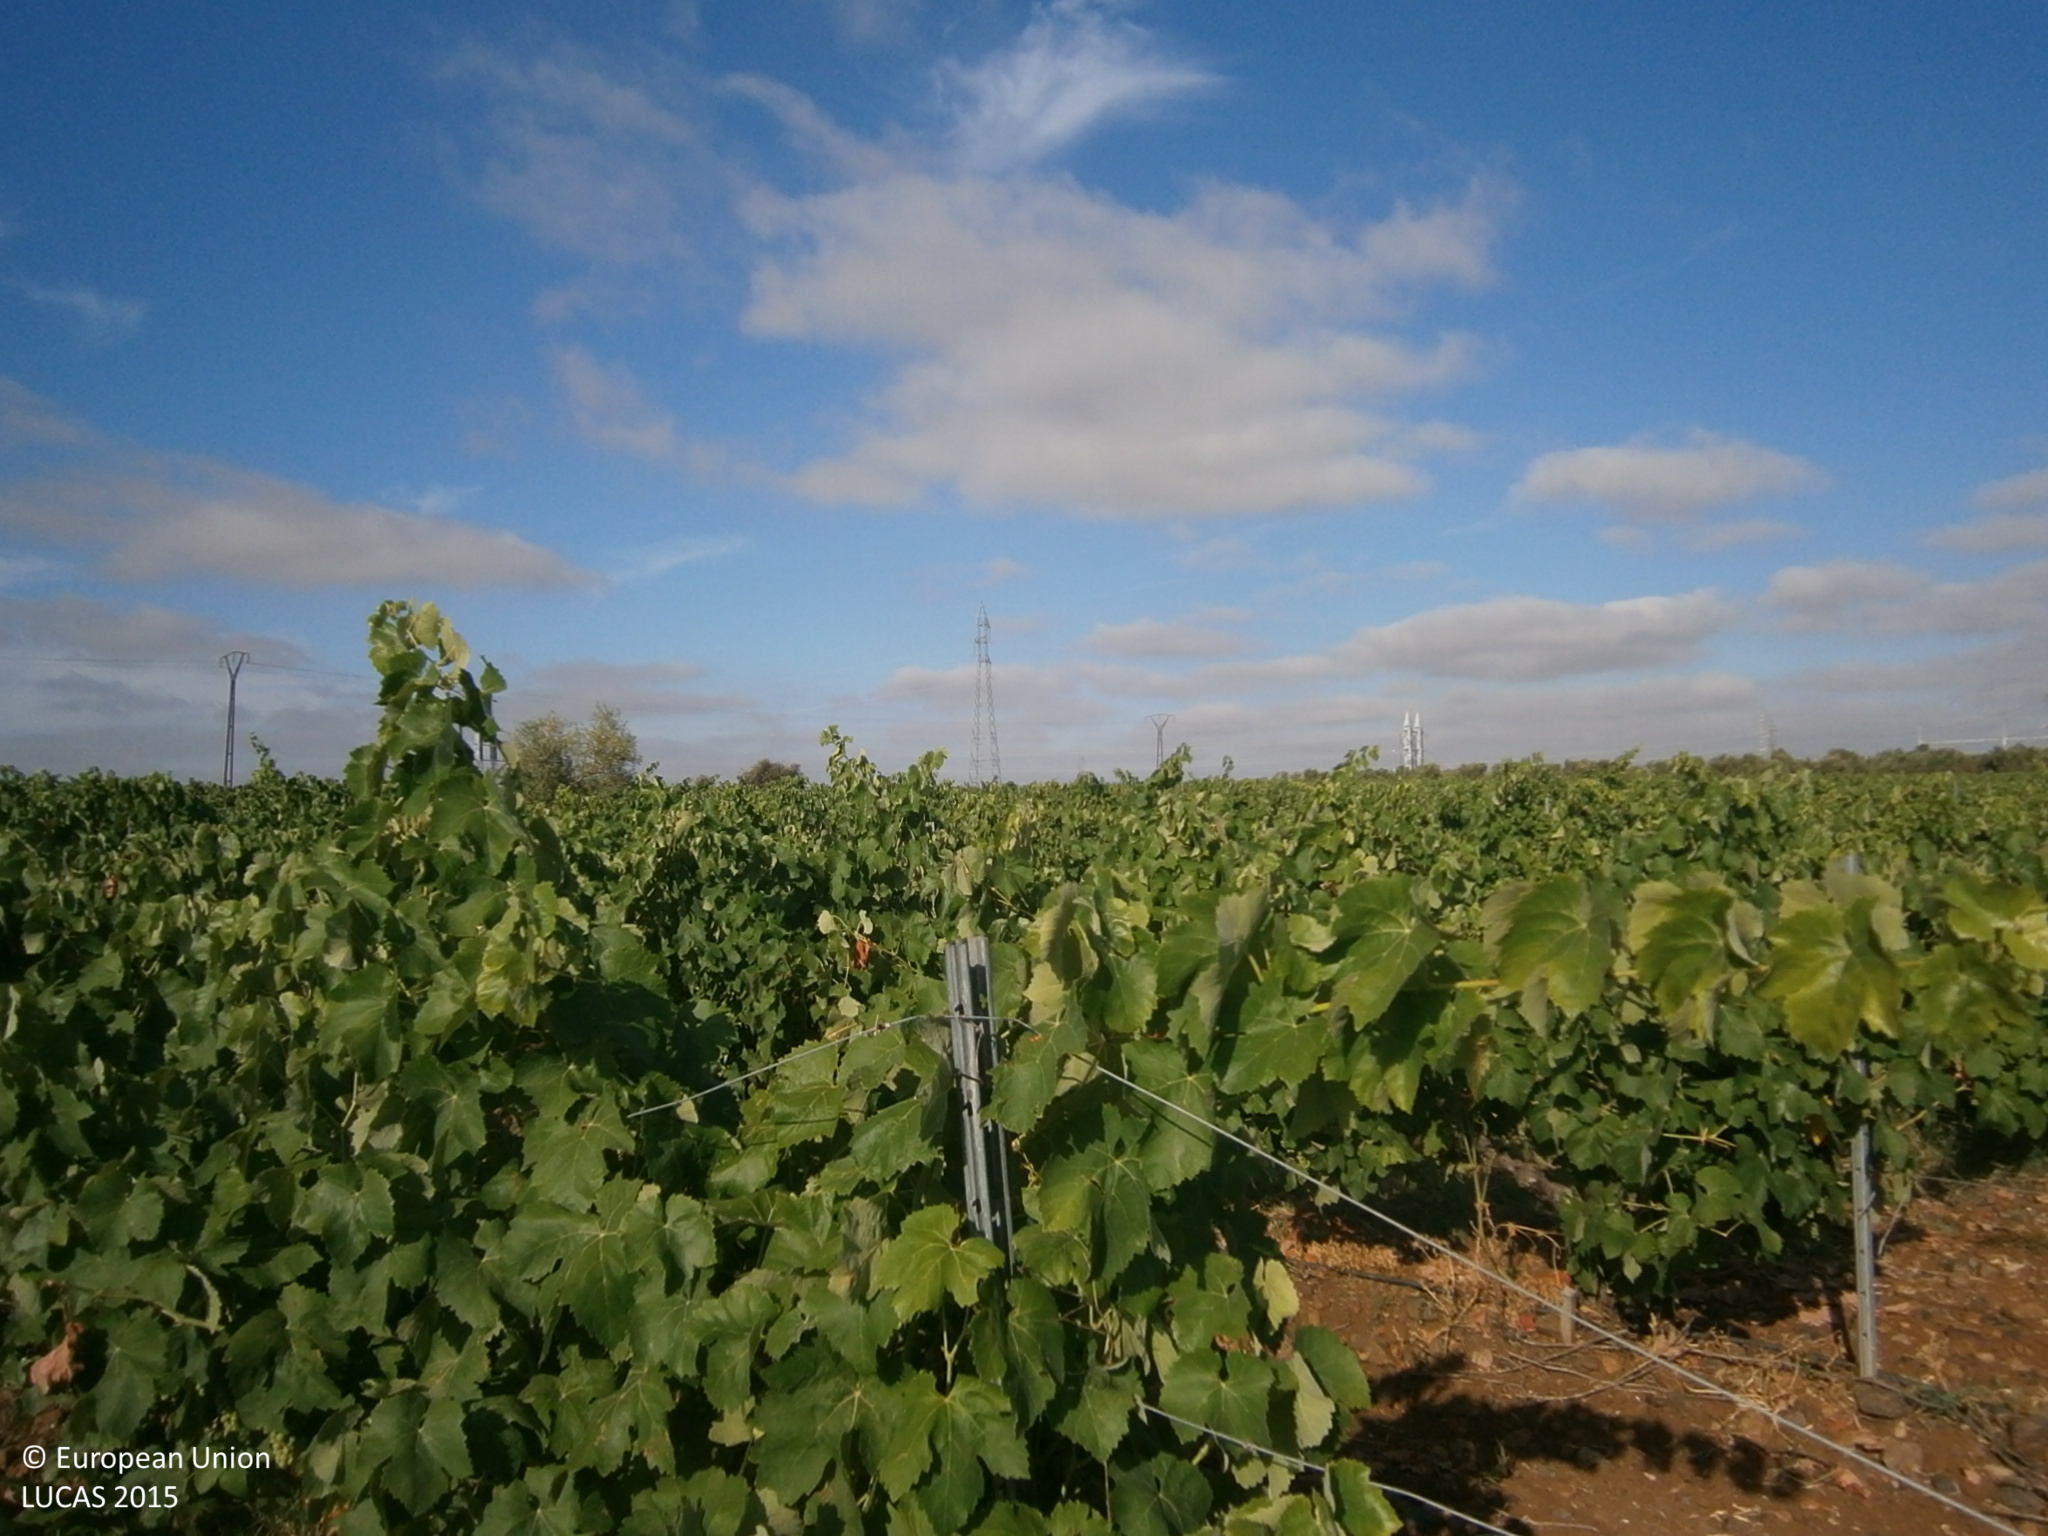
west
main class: Cropland
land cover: Vineyards
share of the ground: 25 - 50 %
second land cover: Spontaneously vegetated surfaces
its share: 25 - 50 %
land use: Agriculture (excluding fallow land and kitchen gardens)
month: June
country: ES
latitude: 38.7153
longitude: -6.7967
